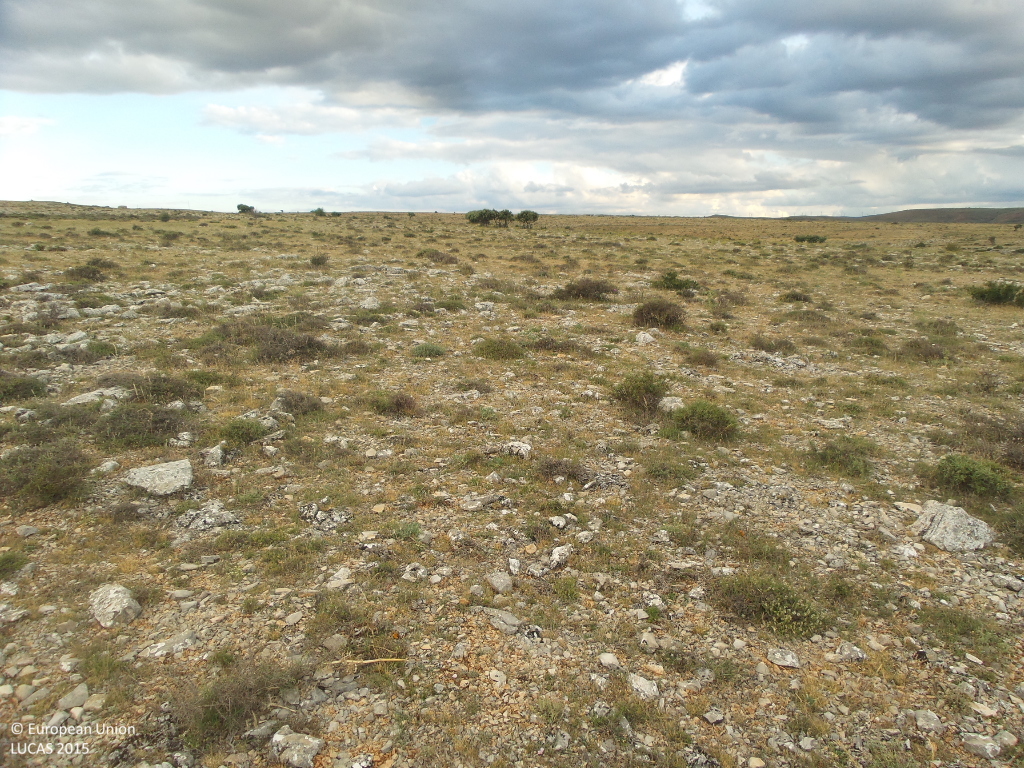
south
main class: Shrubland
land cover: Shrubland without tree cover
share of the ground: 25 - 50 %
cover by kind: unconsolidated bare surface 60 %, shrubs 20 %, herbaceous plants 20 %
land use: Semi-natural and natural areas not in use
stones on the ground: > 50 %
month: June
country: ES
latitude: 41.3659
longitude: -3.0595
